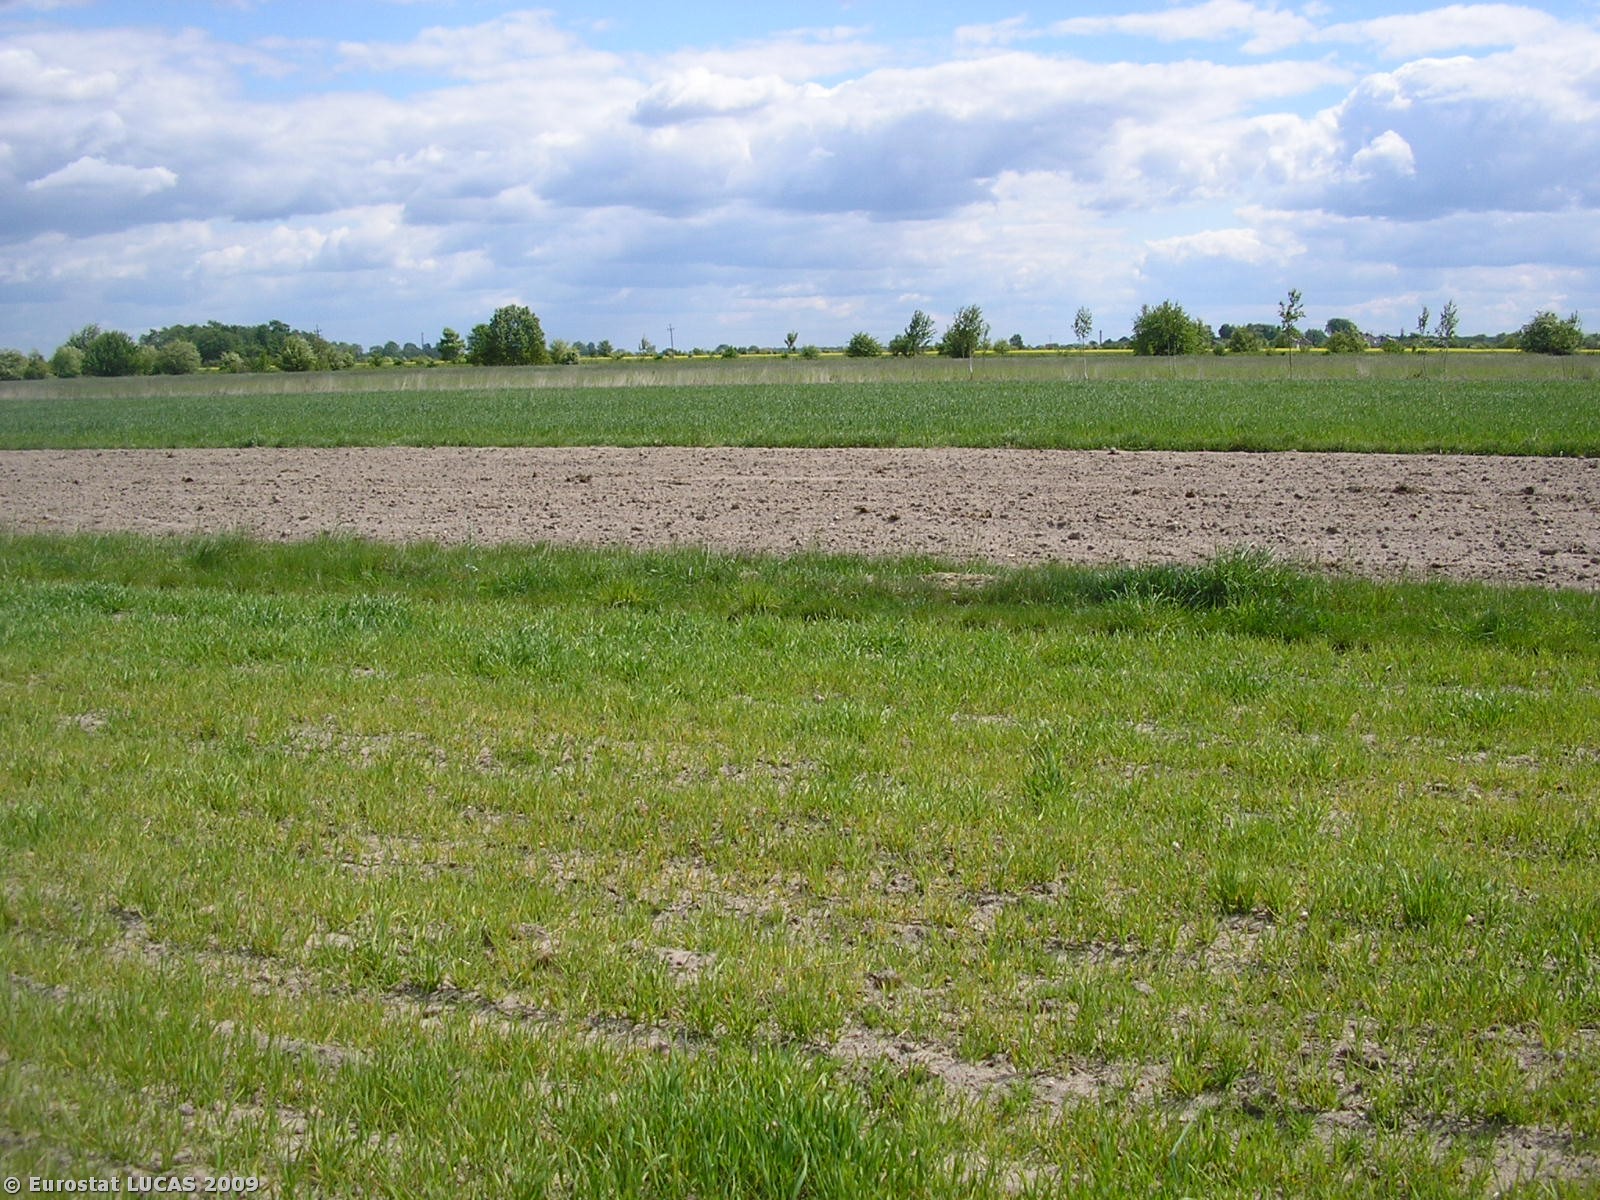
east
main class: Cropland
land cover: Oats
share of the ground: 10 - 25 %
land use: Agriculture (excluding fallow land and kitchen gardens)
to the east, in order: Oats; Tracks; Potatoes; Triticale; Grassland with sparse tree/shrub cover; Rye; Triticale; Rye; Grassland with sparse tree/shrub cover; Other fruit trees and berries
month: May
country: PL
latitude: 51.9848
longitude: 20.0659
